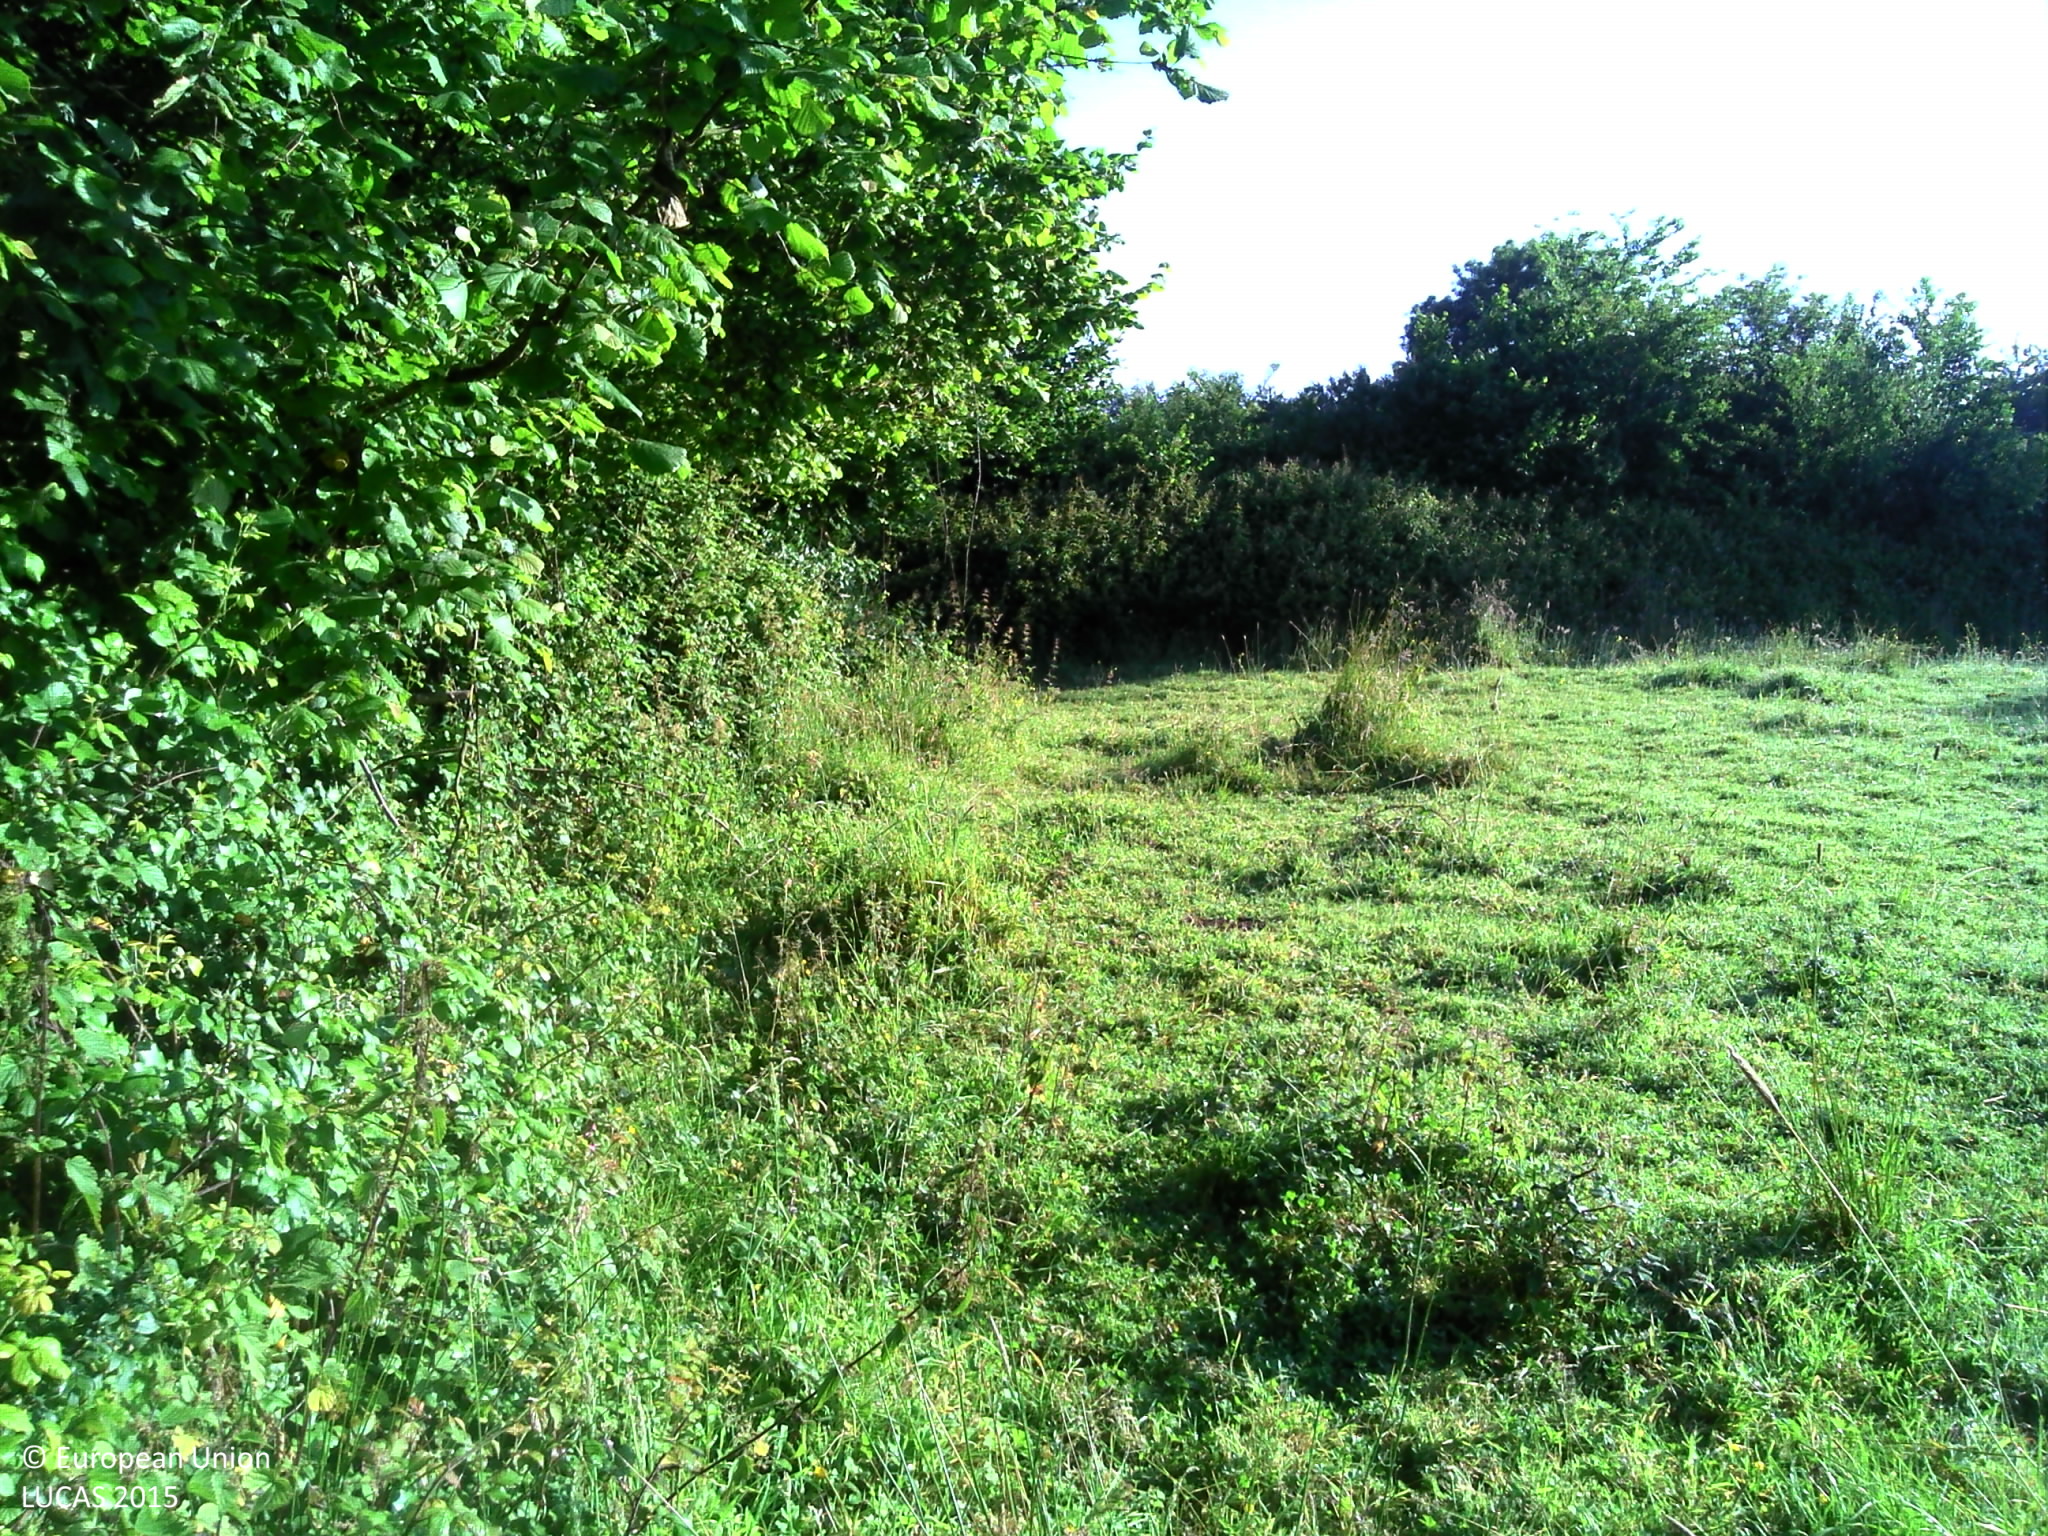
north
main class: Grassland
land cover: Grassland without tree/shrub cover
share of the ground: > 75 %
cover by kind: herbaceous plants 100 %
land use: Agriculture (excluding fallow land and kitchen gardens)
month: June
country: FR
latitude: 49.3349
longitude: -1.4290
